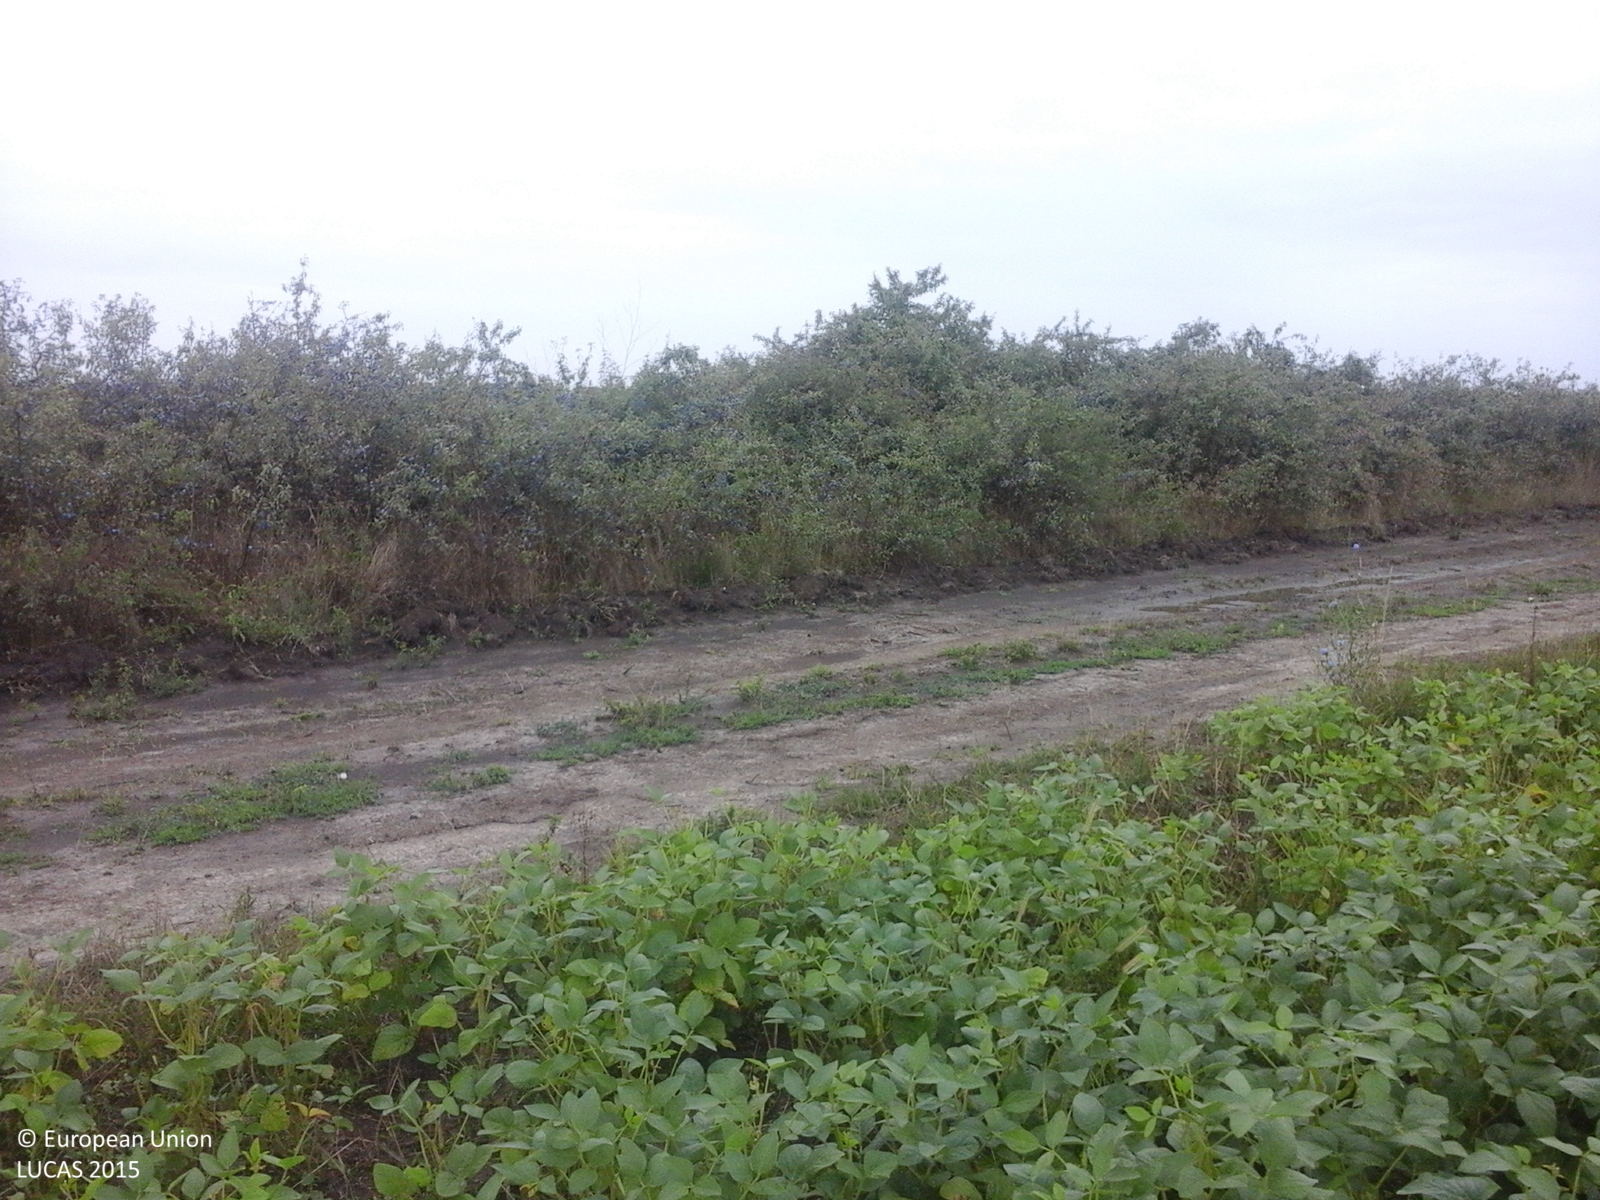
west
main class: Cropland
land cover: Soya
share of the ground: > 75 %
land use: Agriculture (excluding fallow land and kitchen gardens)
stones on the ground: < 10 %
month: August
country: RO
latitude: 45.3853
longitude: 20.9710
